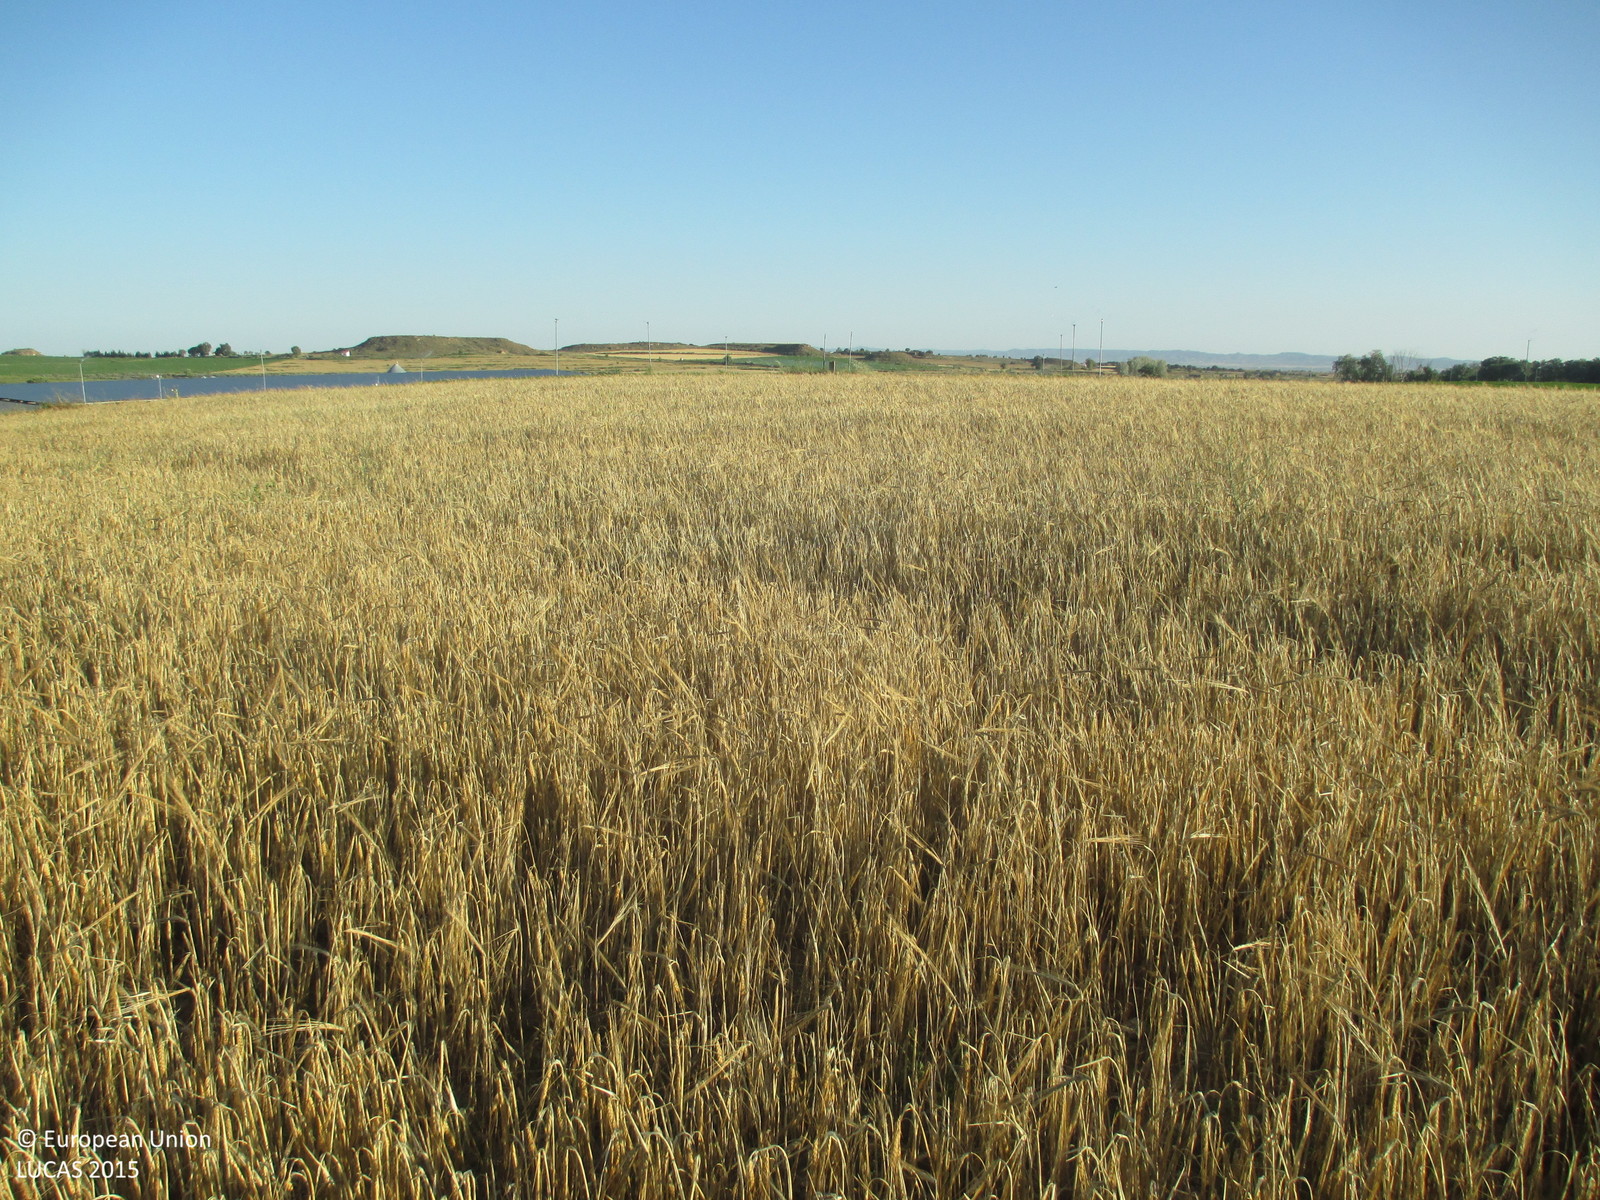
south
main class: Cropland
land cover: Barley
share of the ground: > 75 %
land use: Agriculture (excluding fallow land and kitchen gardens)
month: June
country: ES
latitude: 42.0445
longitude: -0.3995
